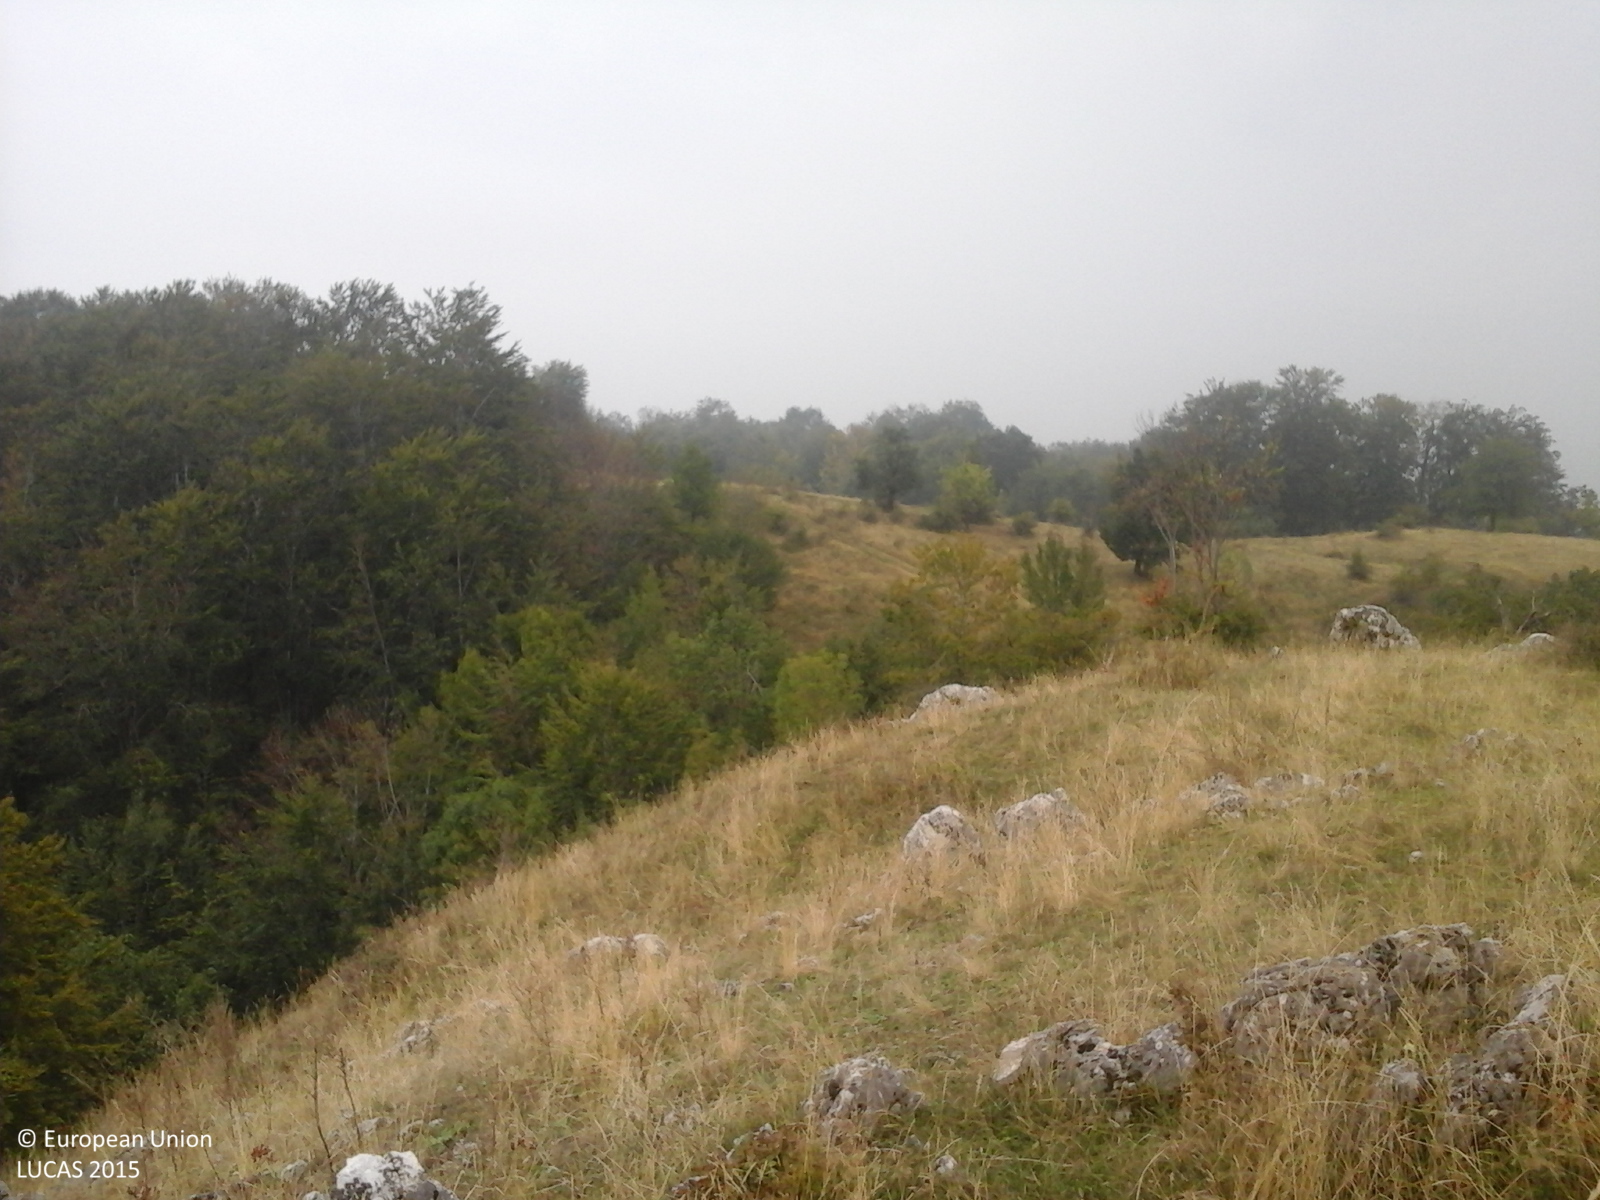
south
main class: Shrubland
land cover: Shrubland without tree cover
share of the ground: > 75 %
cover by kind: shrubs 90 %, herbaceous plants 10 %
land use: Semi-natural and natural areas not in use
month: September
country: RO
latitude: 45.0782
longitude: 22.8653
